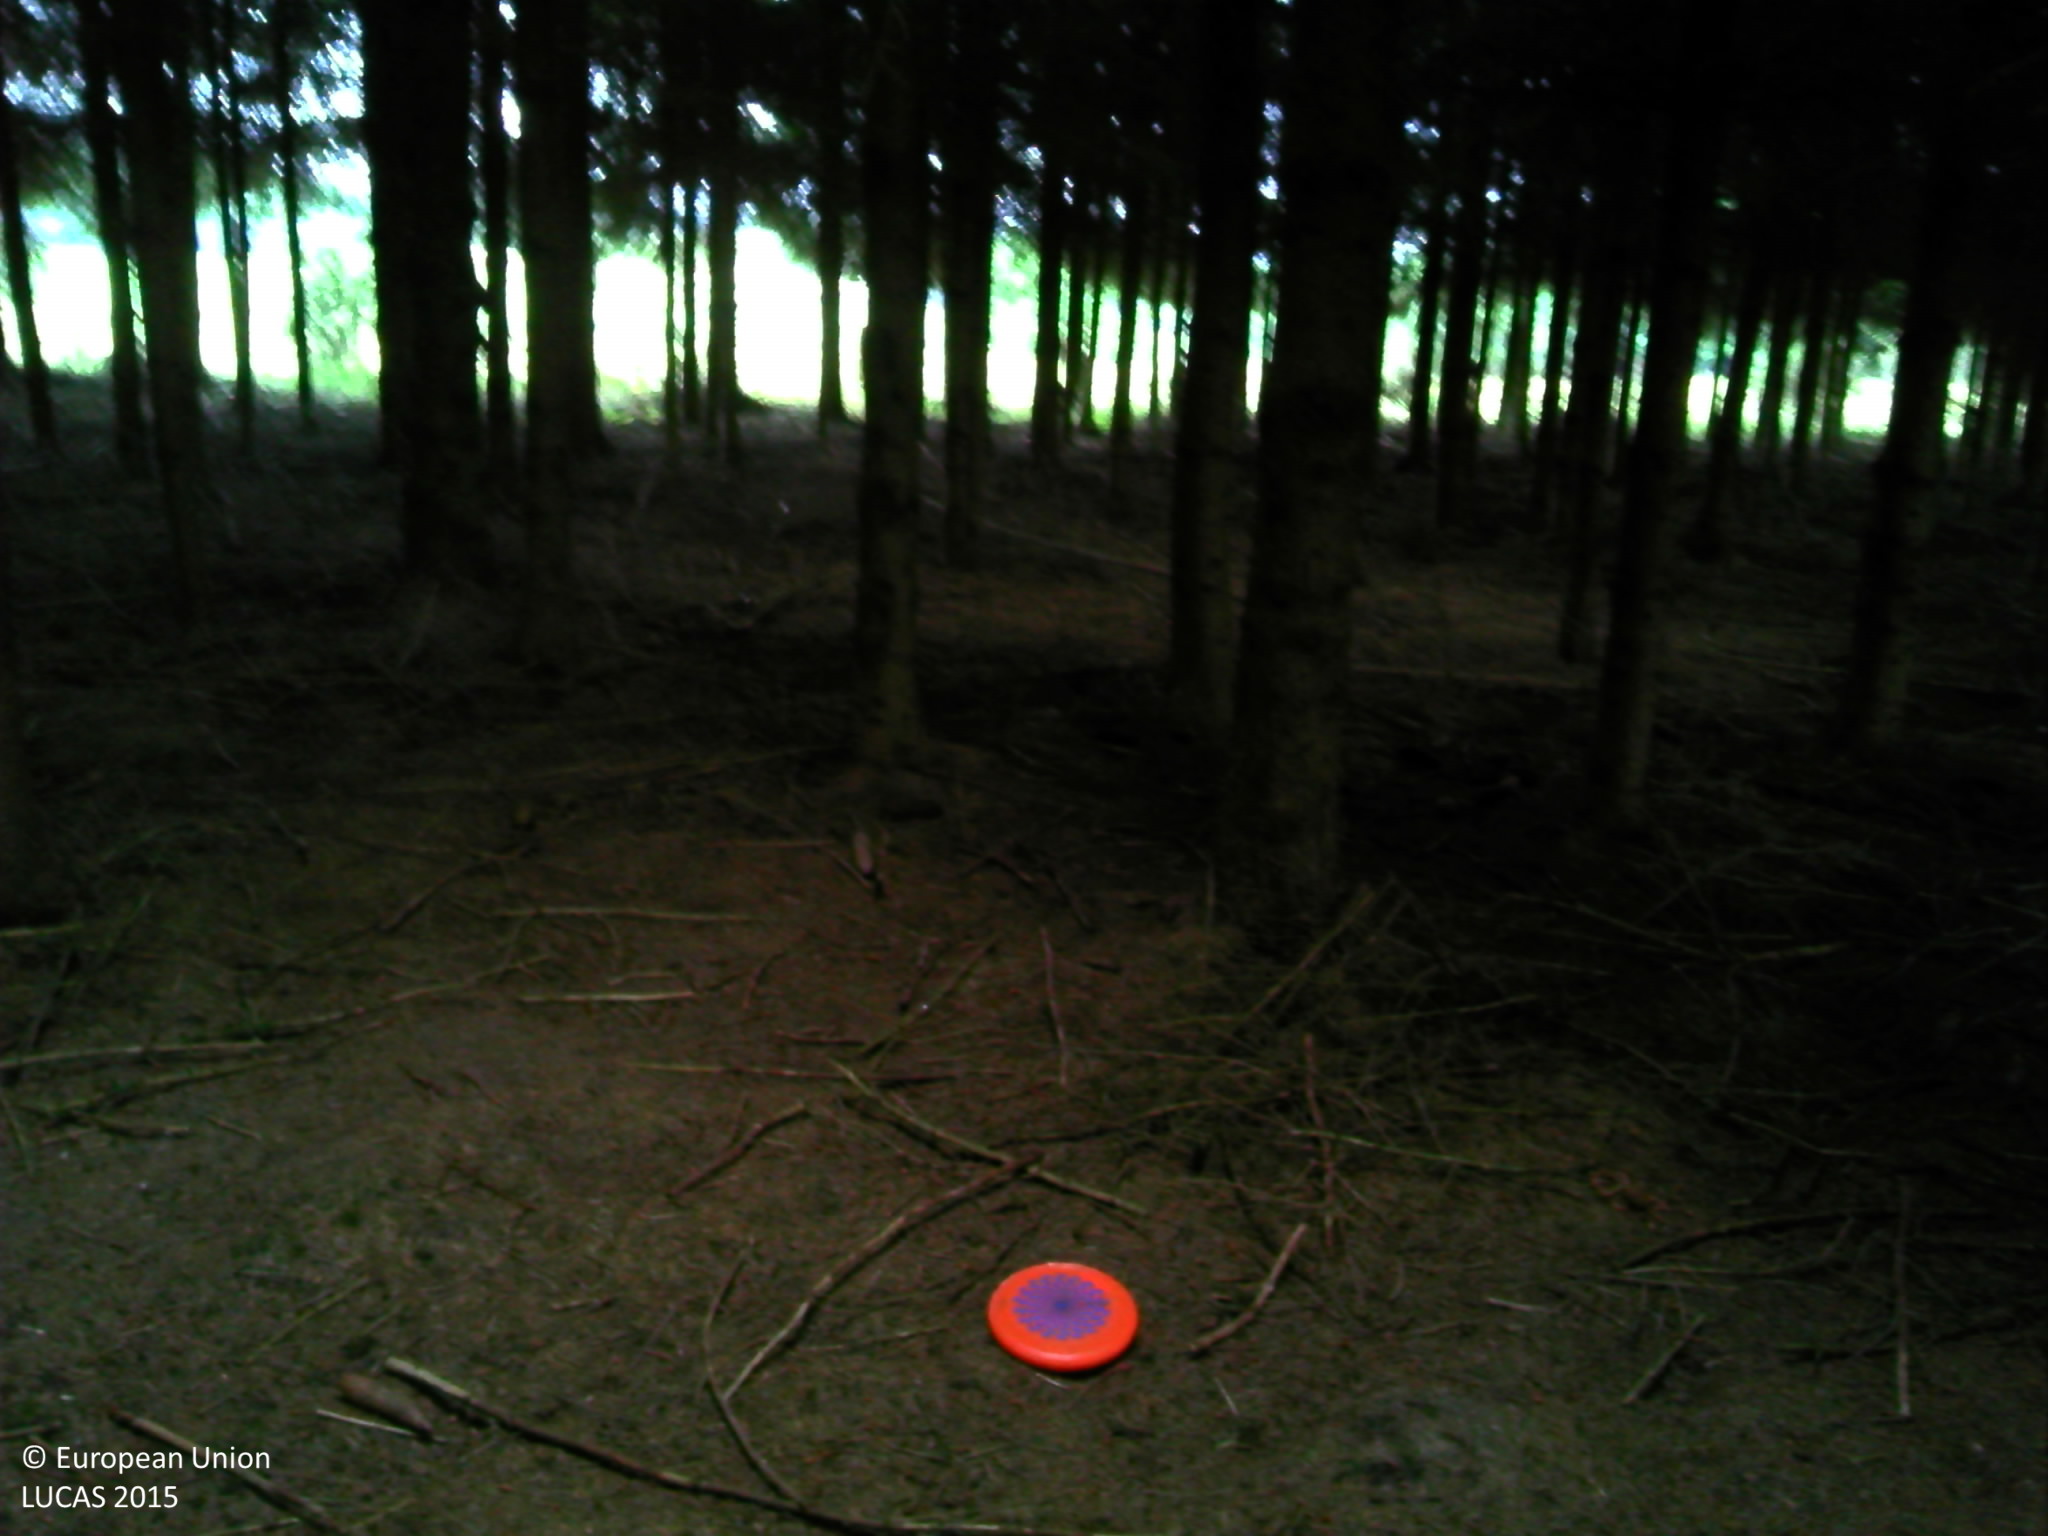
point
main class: Woodland
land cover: Spruce dominated coniferous woodland
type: hemiboreal forest and nemoral coniferous forest and mixed broadleaved-coniferous forest
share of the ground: > 75 %
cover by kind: coniferous forest trees 95 %, unconsolidated bare surface 5 %
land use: Forestry
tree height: > 5 m
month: July
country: BE
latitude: 50.1824
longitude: 5.8957
